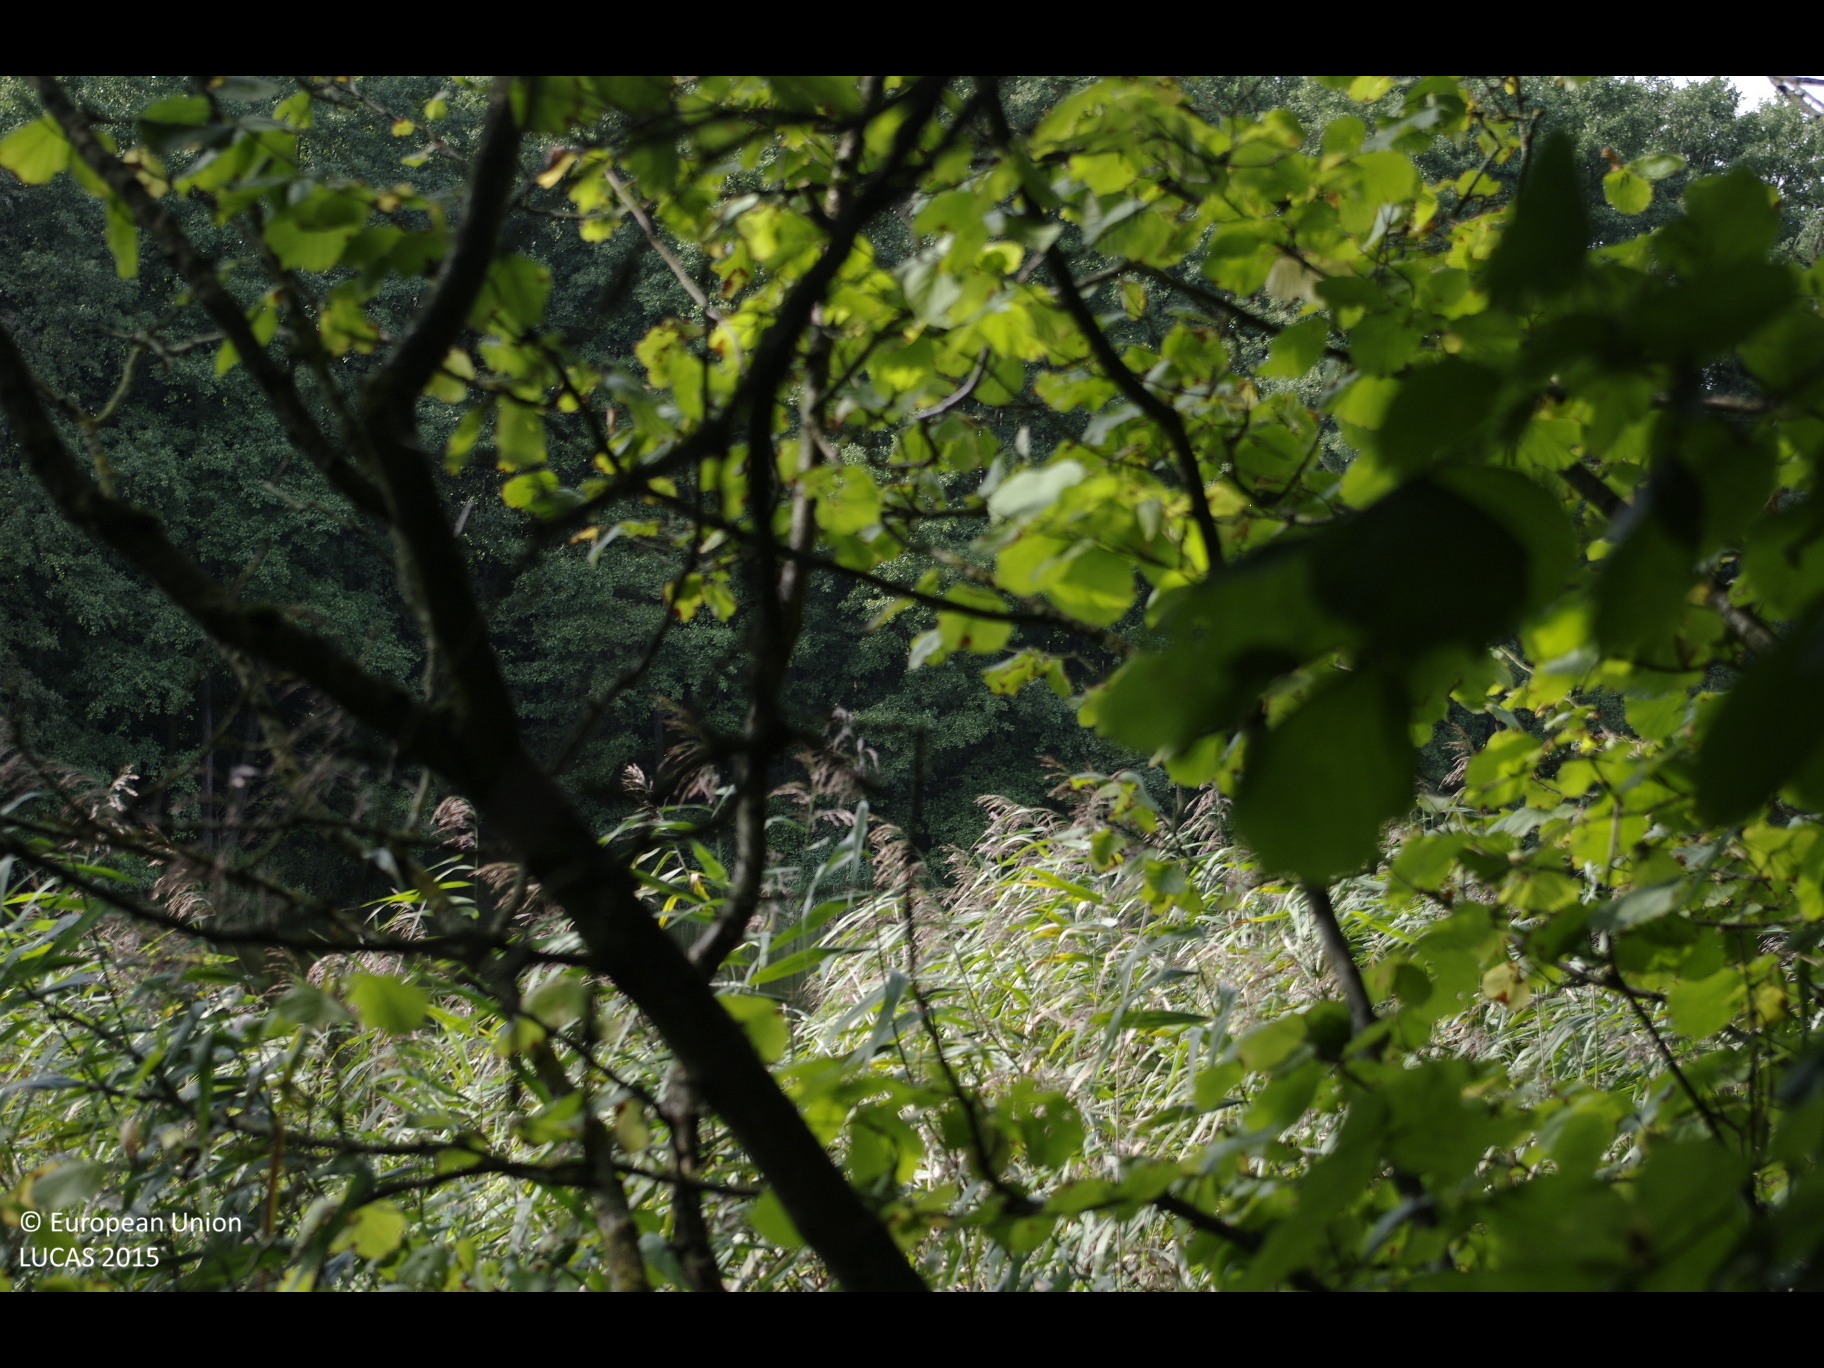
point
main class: Woodland
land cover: Broadleaved woodland
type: mire and swamp forests
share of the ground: 50 - 75 %
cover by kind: broadleaved forest trees 70 %, herbaceous plants 30 %
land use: Semi-natural and natural areas not in use
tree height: > 5 m
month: September
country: DE
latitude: 53.5441
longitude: 10.6184
